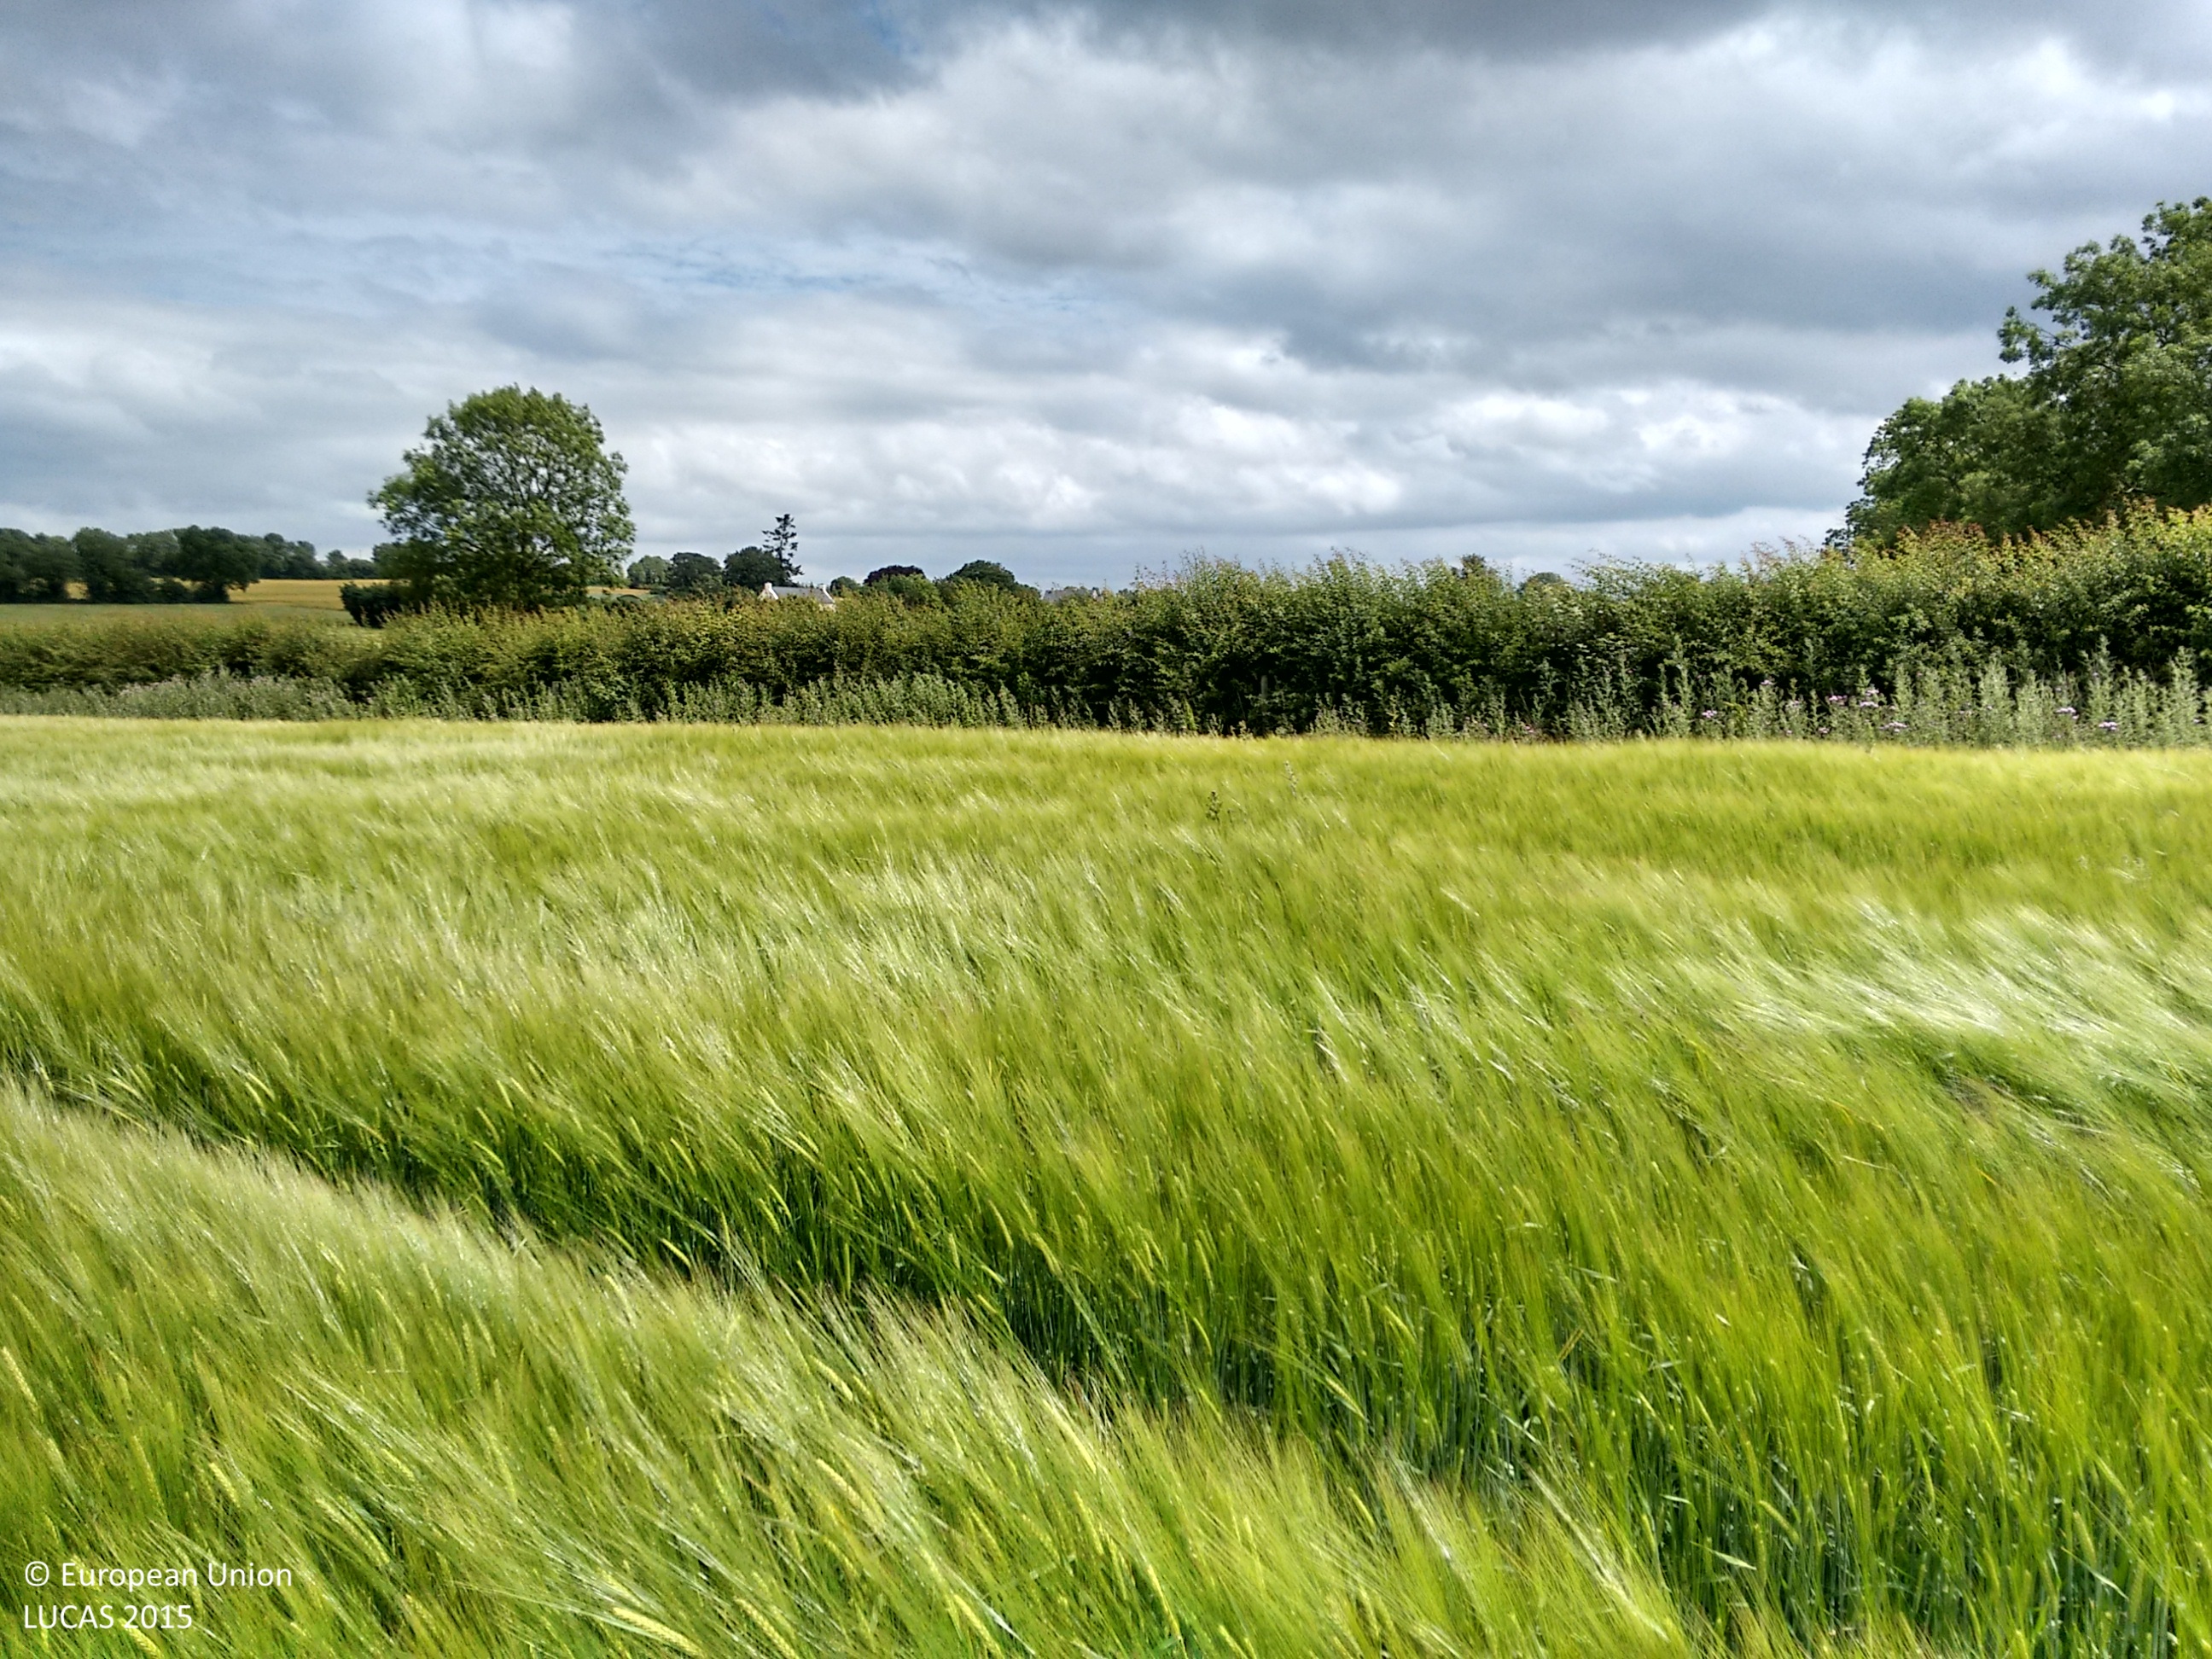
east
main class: Cropland
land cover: Barley
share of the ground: > 75 %
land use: Agriculture (excluding fallow land and kitchen gardens)
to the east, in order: Barley; Fences; Managed hedges; Fences; Other bare soil; Fences; Barley
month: July
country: IE
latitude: 52.9833
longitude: -6.8345
